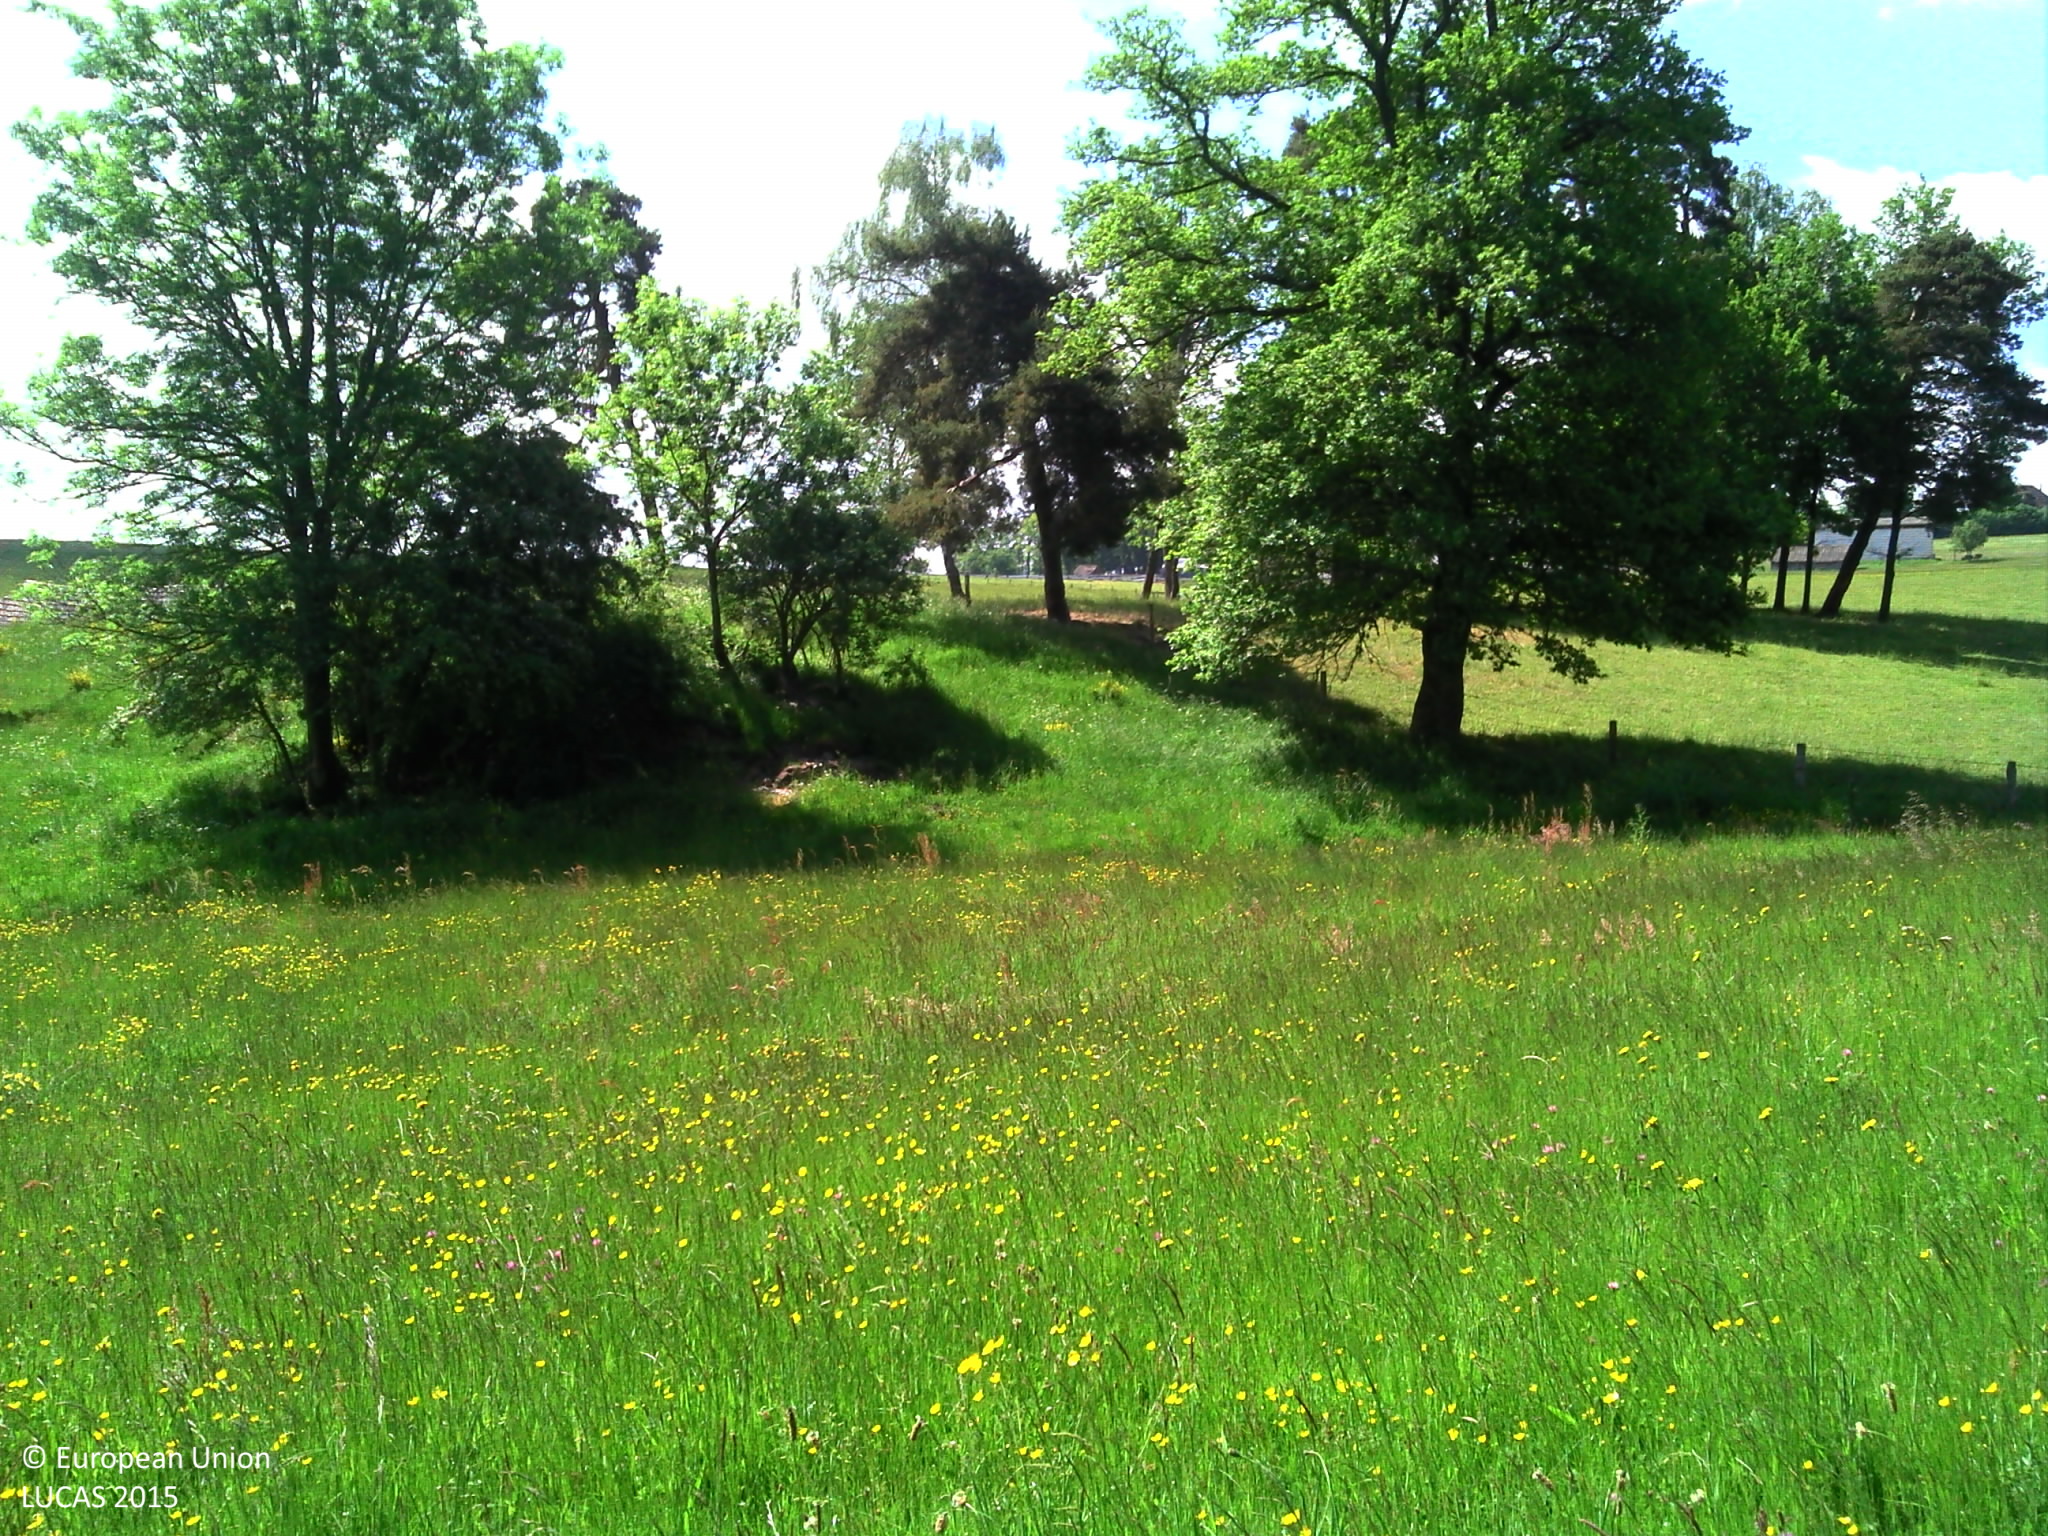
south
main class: Grassland
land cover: Grassland with sparse tree/shrub cover
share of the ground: > 75 %
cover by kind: herbaceous plants 95 %, broadleaved forest trees 5 %
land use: Agriculture (excluding fallow land and kitchen gardens)
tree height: > 5 m
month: June
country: FR
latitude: 44.9430
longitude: 3.2228
